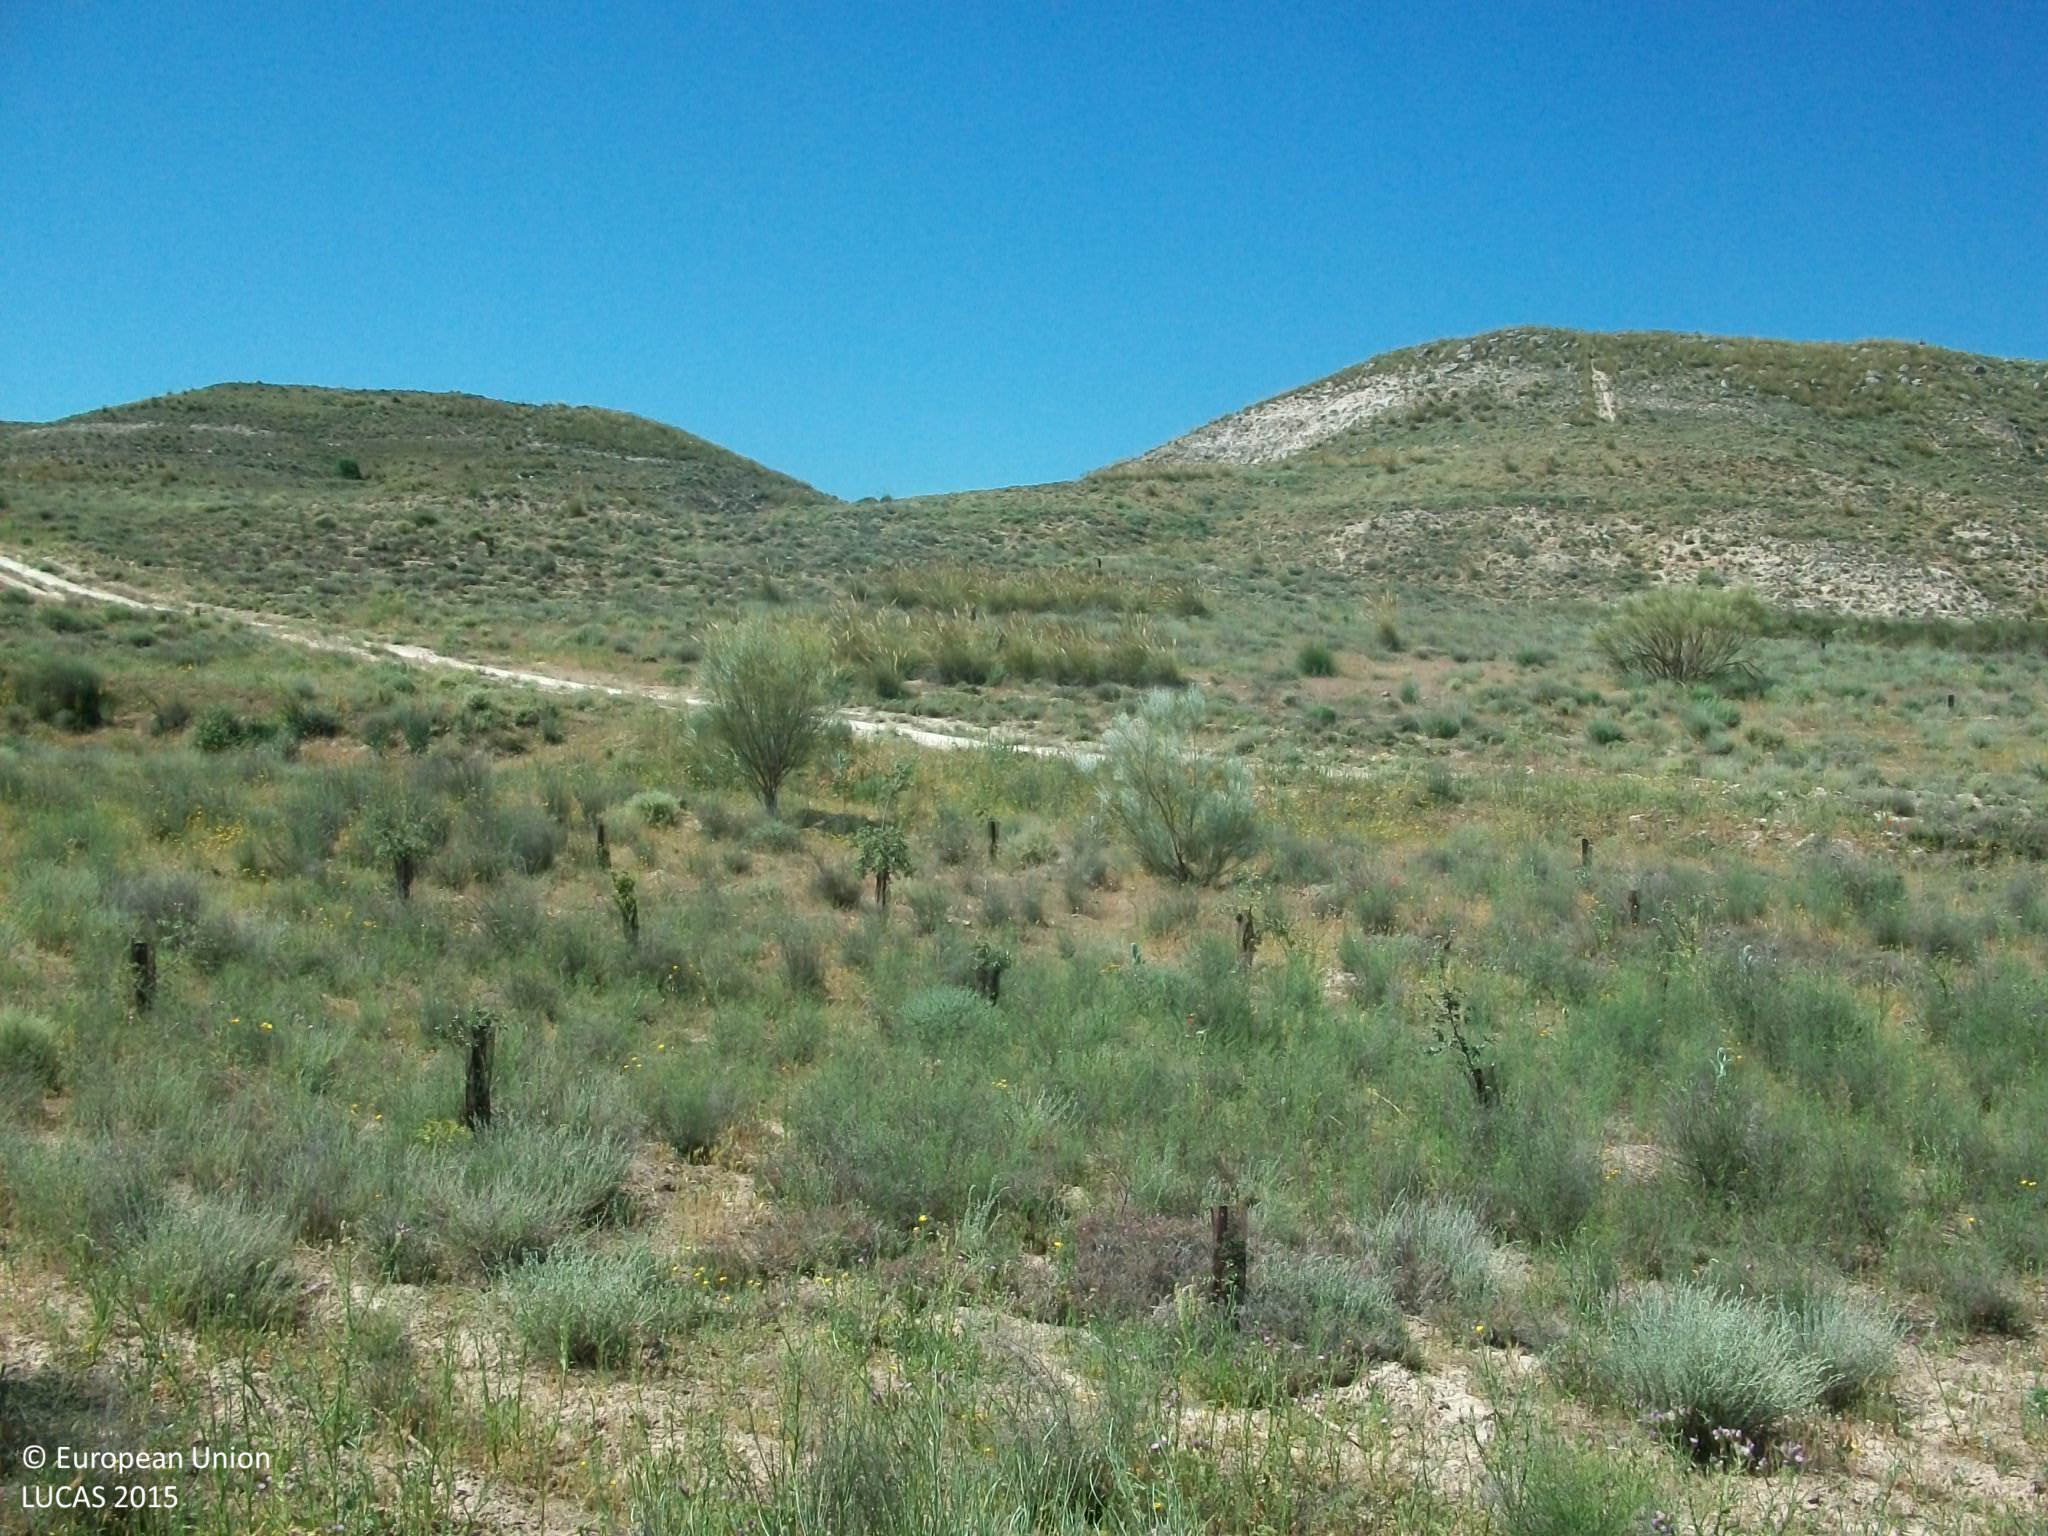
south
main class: Shrubland
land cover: Shrubland with sparse tree cover
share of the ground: > 75 %
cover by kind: shrubs 80 %, consolidated bare surface 15 %, broadleaved forest trees 5 %
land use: Semi-natural and natural areas not in use
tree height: < 5 m
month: May
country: ES
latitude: 39.8939
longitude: -3.6549
